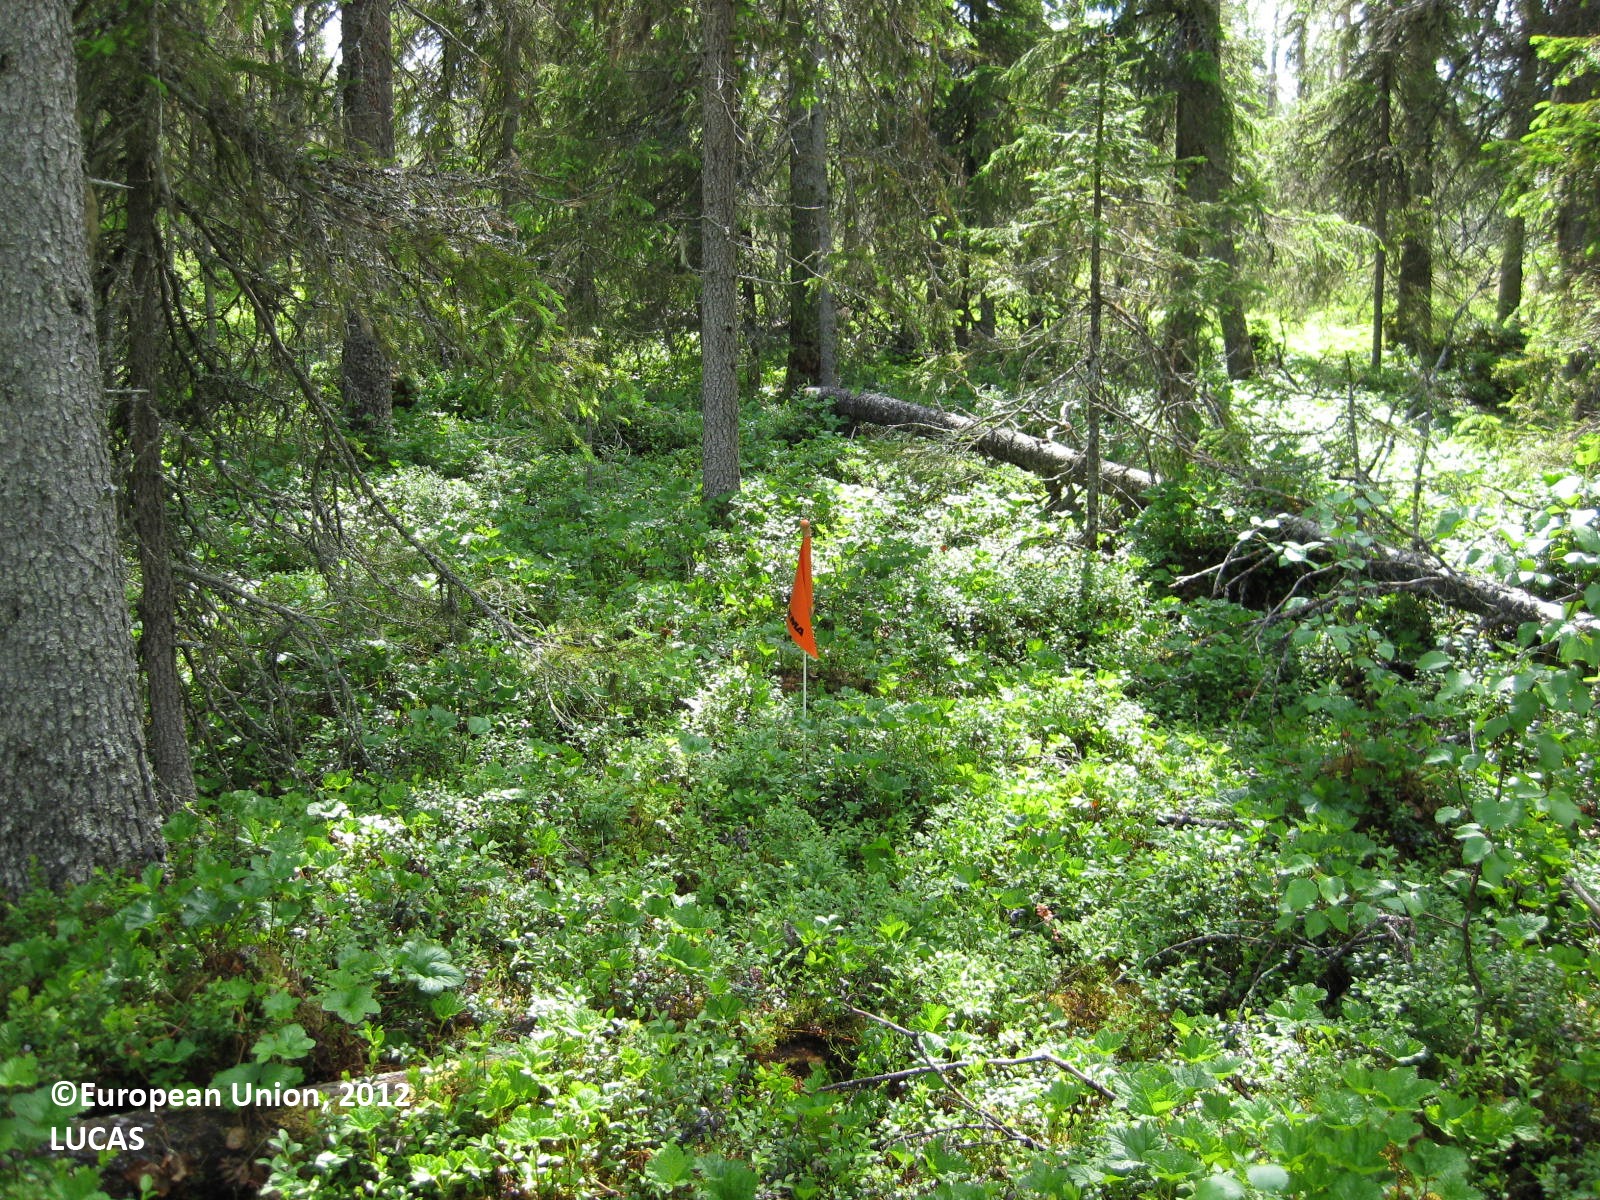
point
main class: Woodland
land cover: Spruce dominated coniferous woodland
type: boreal forest
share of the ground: > 75 %
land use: Forestry
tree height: > 5 m
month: July
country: FI
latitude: 65.6379
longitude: 29.5561
